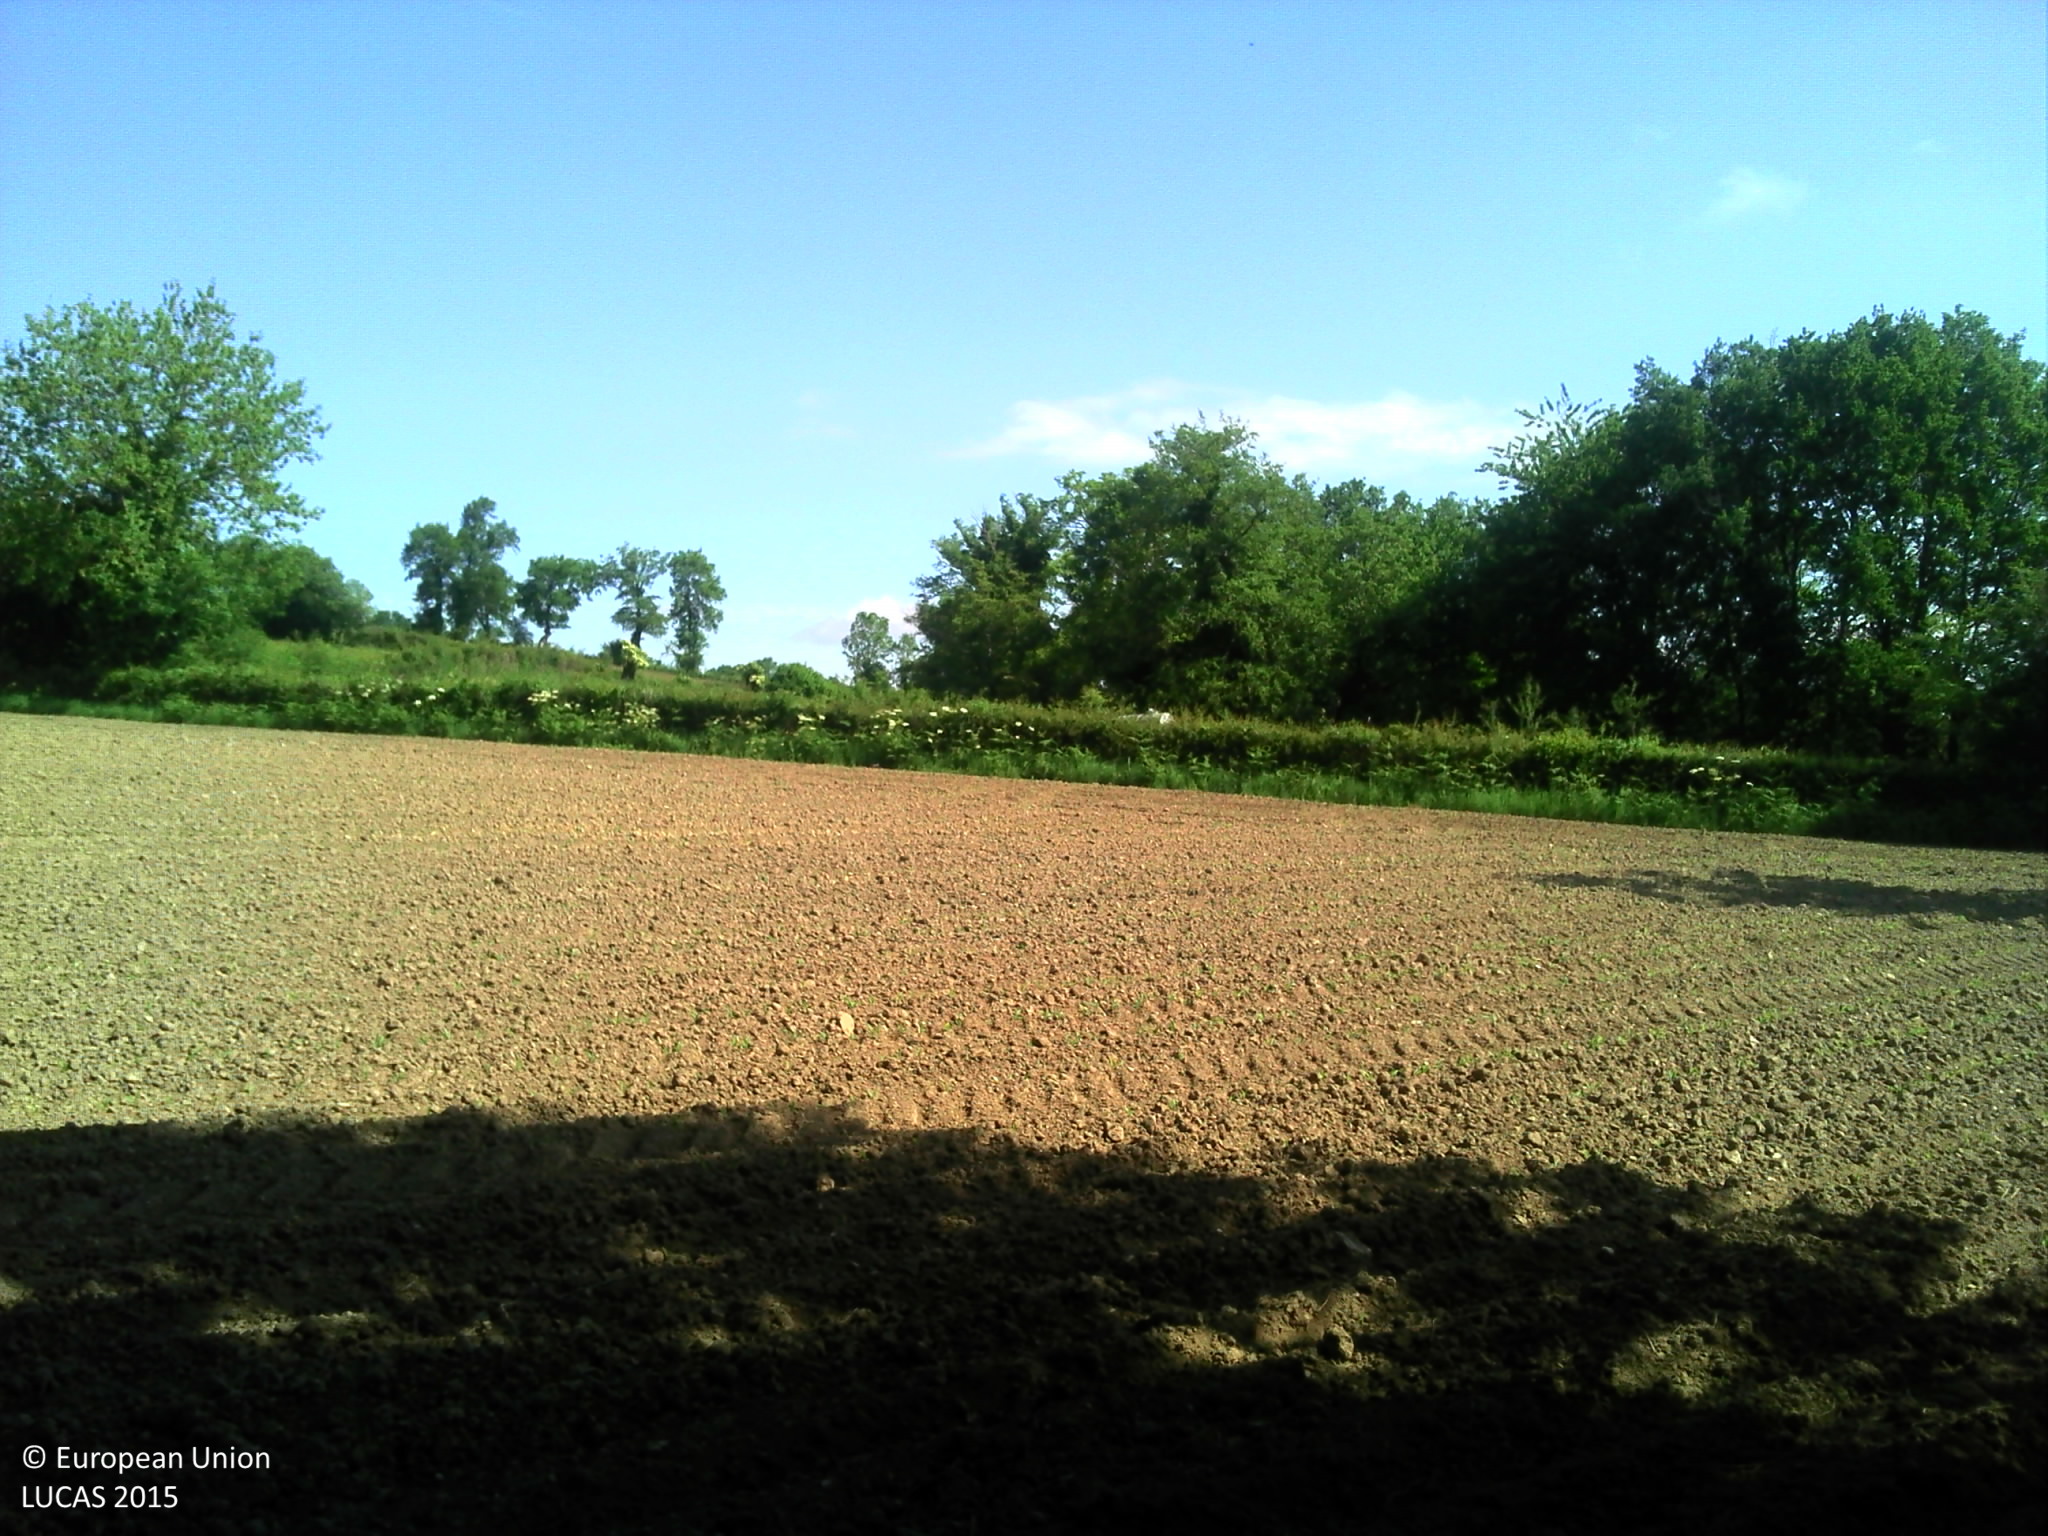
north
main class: Grassland
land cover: Grassland without tree/shrub cover
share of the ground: > 75 %
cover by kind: herbaceous plants 100 %
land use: Agriculture (excluding fallow land and kitchen gardens)
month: May
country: FR
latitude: 46.2315
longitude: 2.7487
